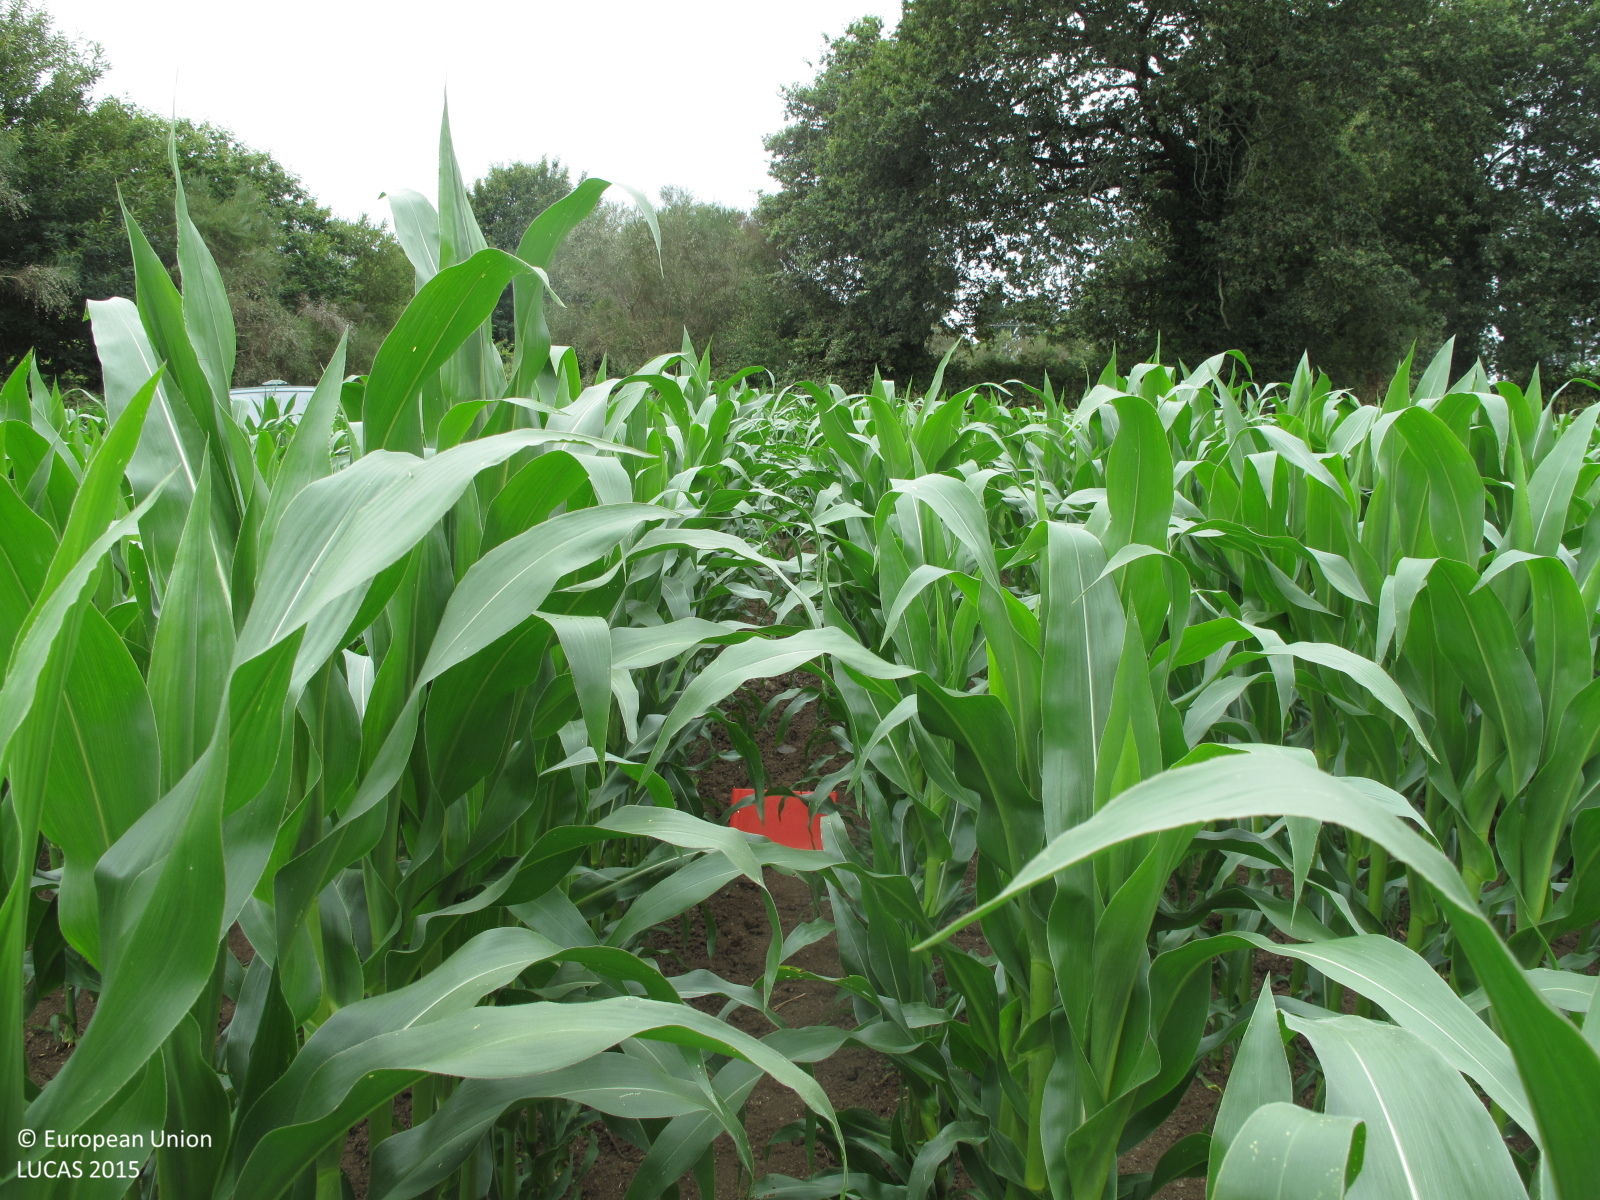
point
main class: Cropland
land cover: Maize
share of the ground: > 75 %
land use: Agriculture (excluding fallow land and kitchen gardens)
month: July
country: ES
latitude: 43.1380
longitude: -8.0552
